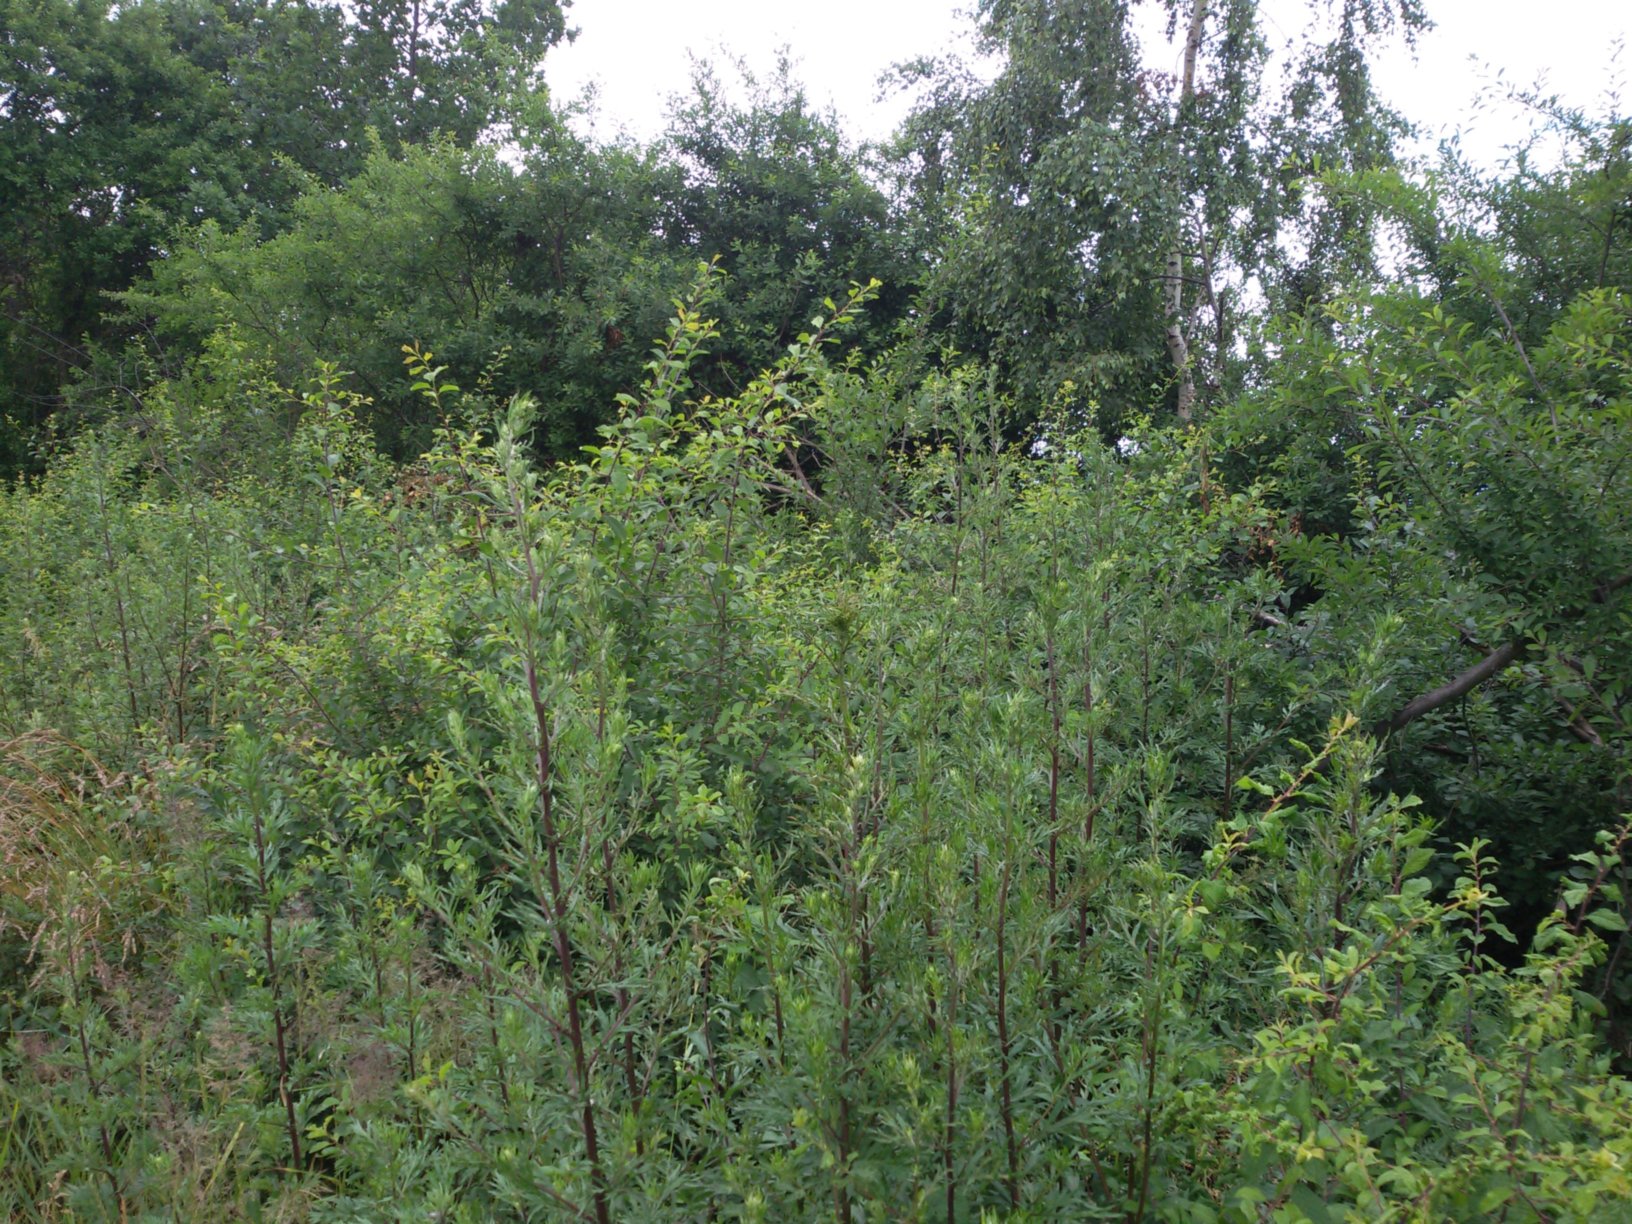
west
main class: Shrubland
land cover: Shrubland with sparse tree cover
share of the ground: > 75 %
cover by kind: shrubs 95 %, broadleaved forest trees 5 %
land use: Semi-natural and natural areas not in use
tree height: < 5 m
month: June
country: PL
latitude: 50.7314
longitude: 17.2226
